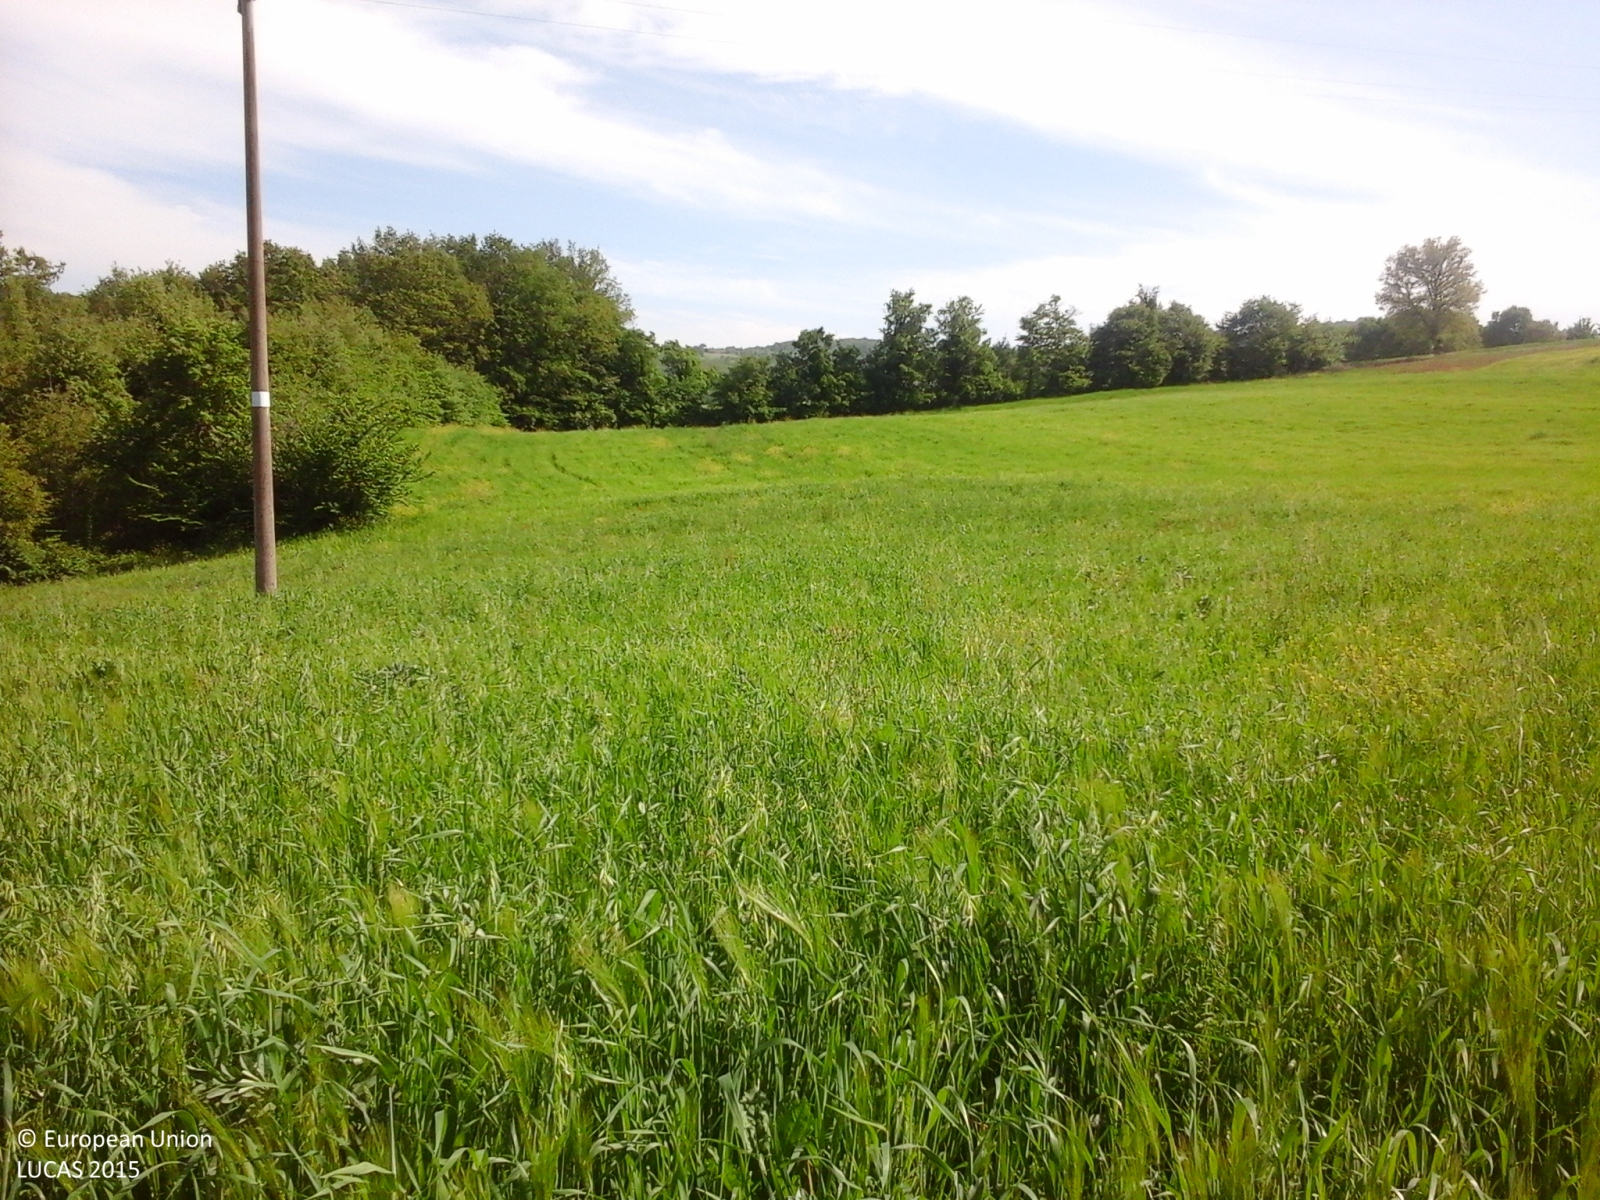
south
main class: Cropland
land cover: Barley
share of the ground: > 75 %
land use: Agriculture (excluding fallow land and kitchen gardens)
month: May
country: IT
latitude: 41.3323
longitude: 14.7026
